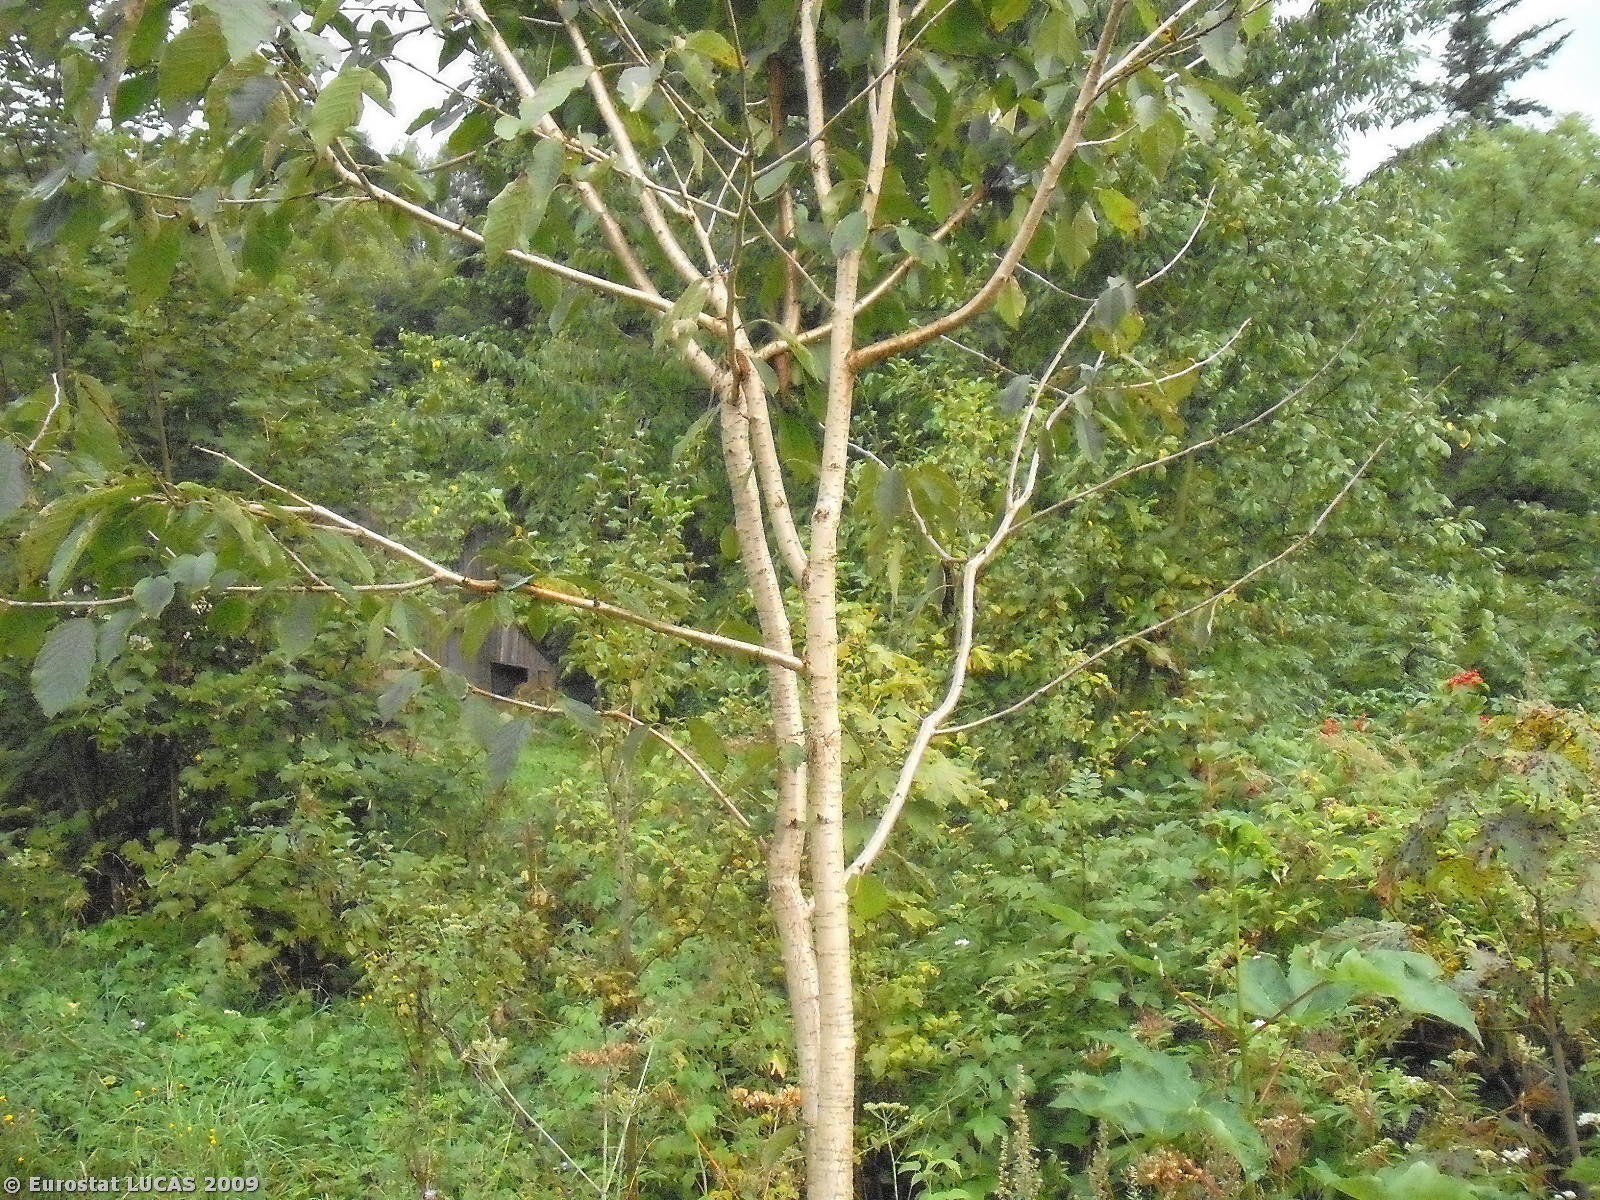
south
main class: Woodland
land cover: Mixed woodland
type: mesophytic deciduous forest
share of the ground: > 75 %
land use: Unused
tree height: > 5 m
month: August
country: PL
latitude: 49.8386
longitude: 22.0011
